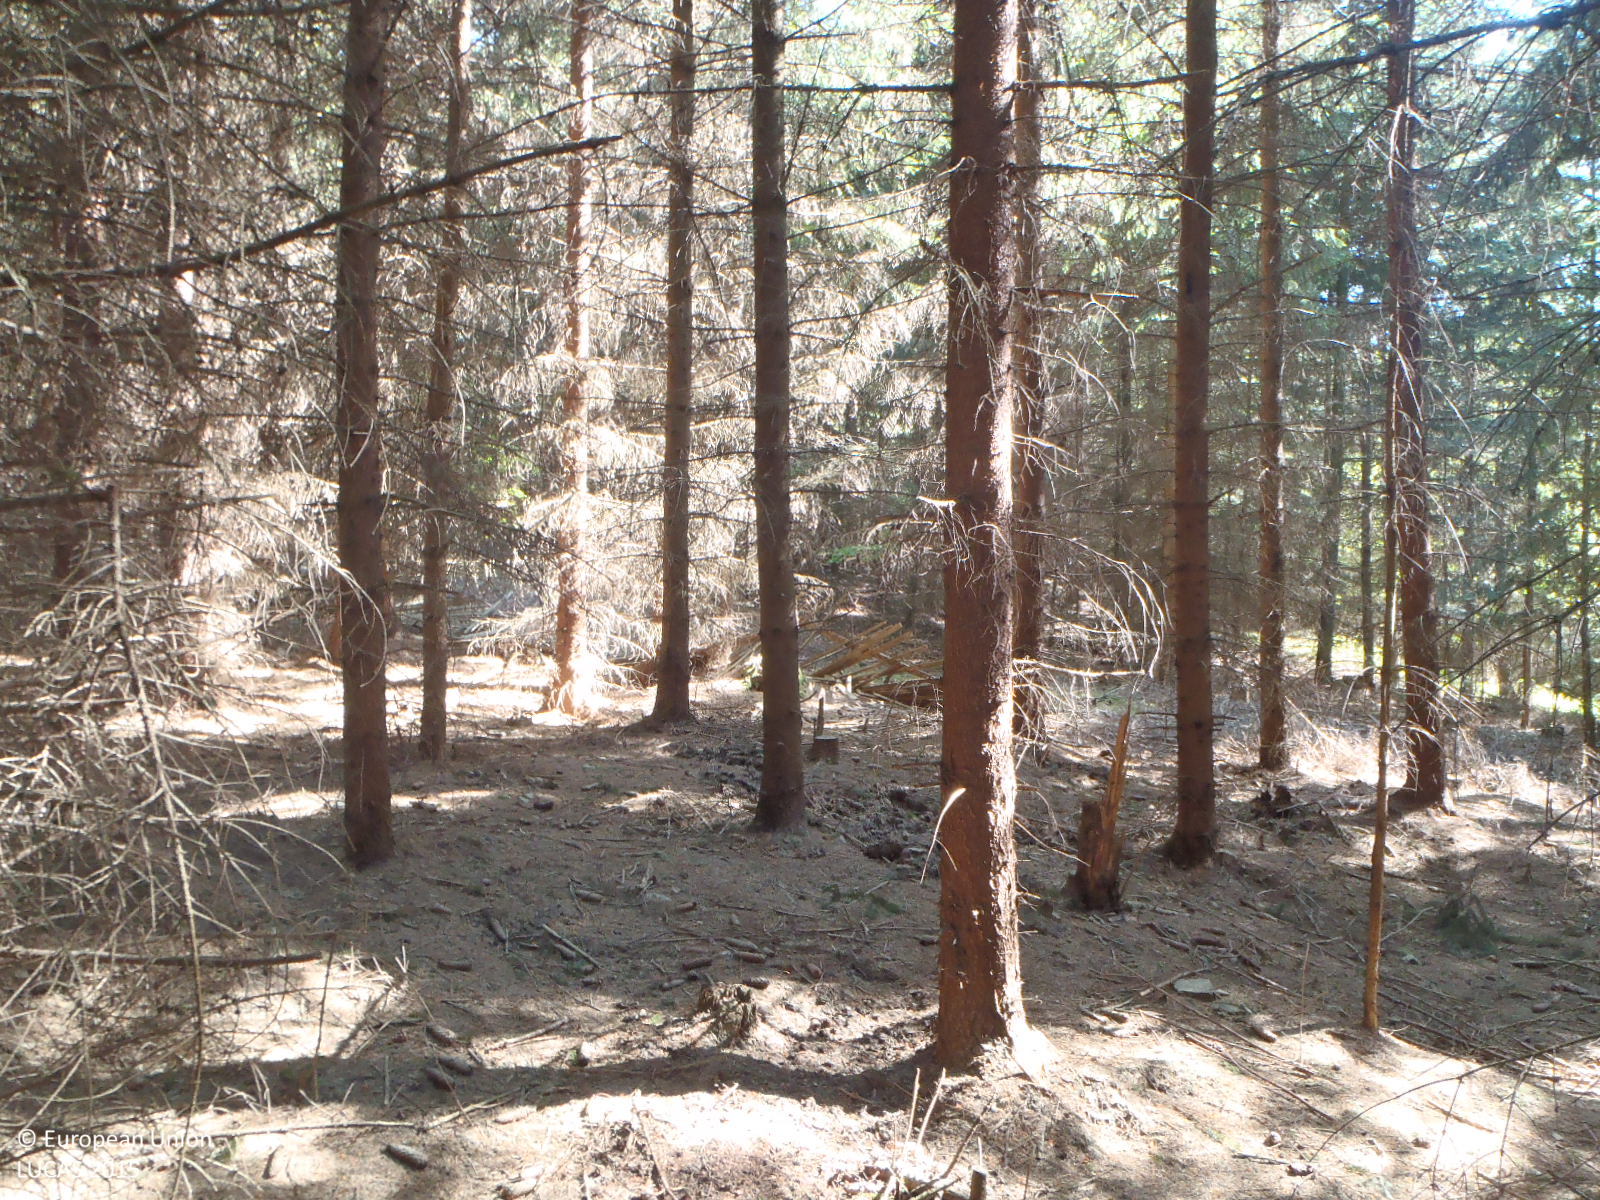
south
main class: Woodland
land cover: Spruce dominated coniferous woodland
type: hemiboreal forest and nemoral coniferous forest and mixed broadleaved-coniferous forest
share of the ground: > 75 %
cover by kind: coniferous forest trees 95 %, unconsolidated bare surface 5 %
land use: Forestry
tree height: > 5 m
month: May
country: CZ
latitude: 49.1116
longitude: 15.5519
